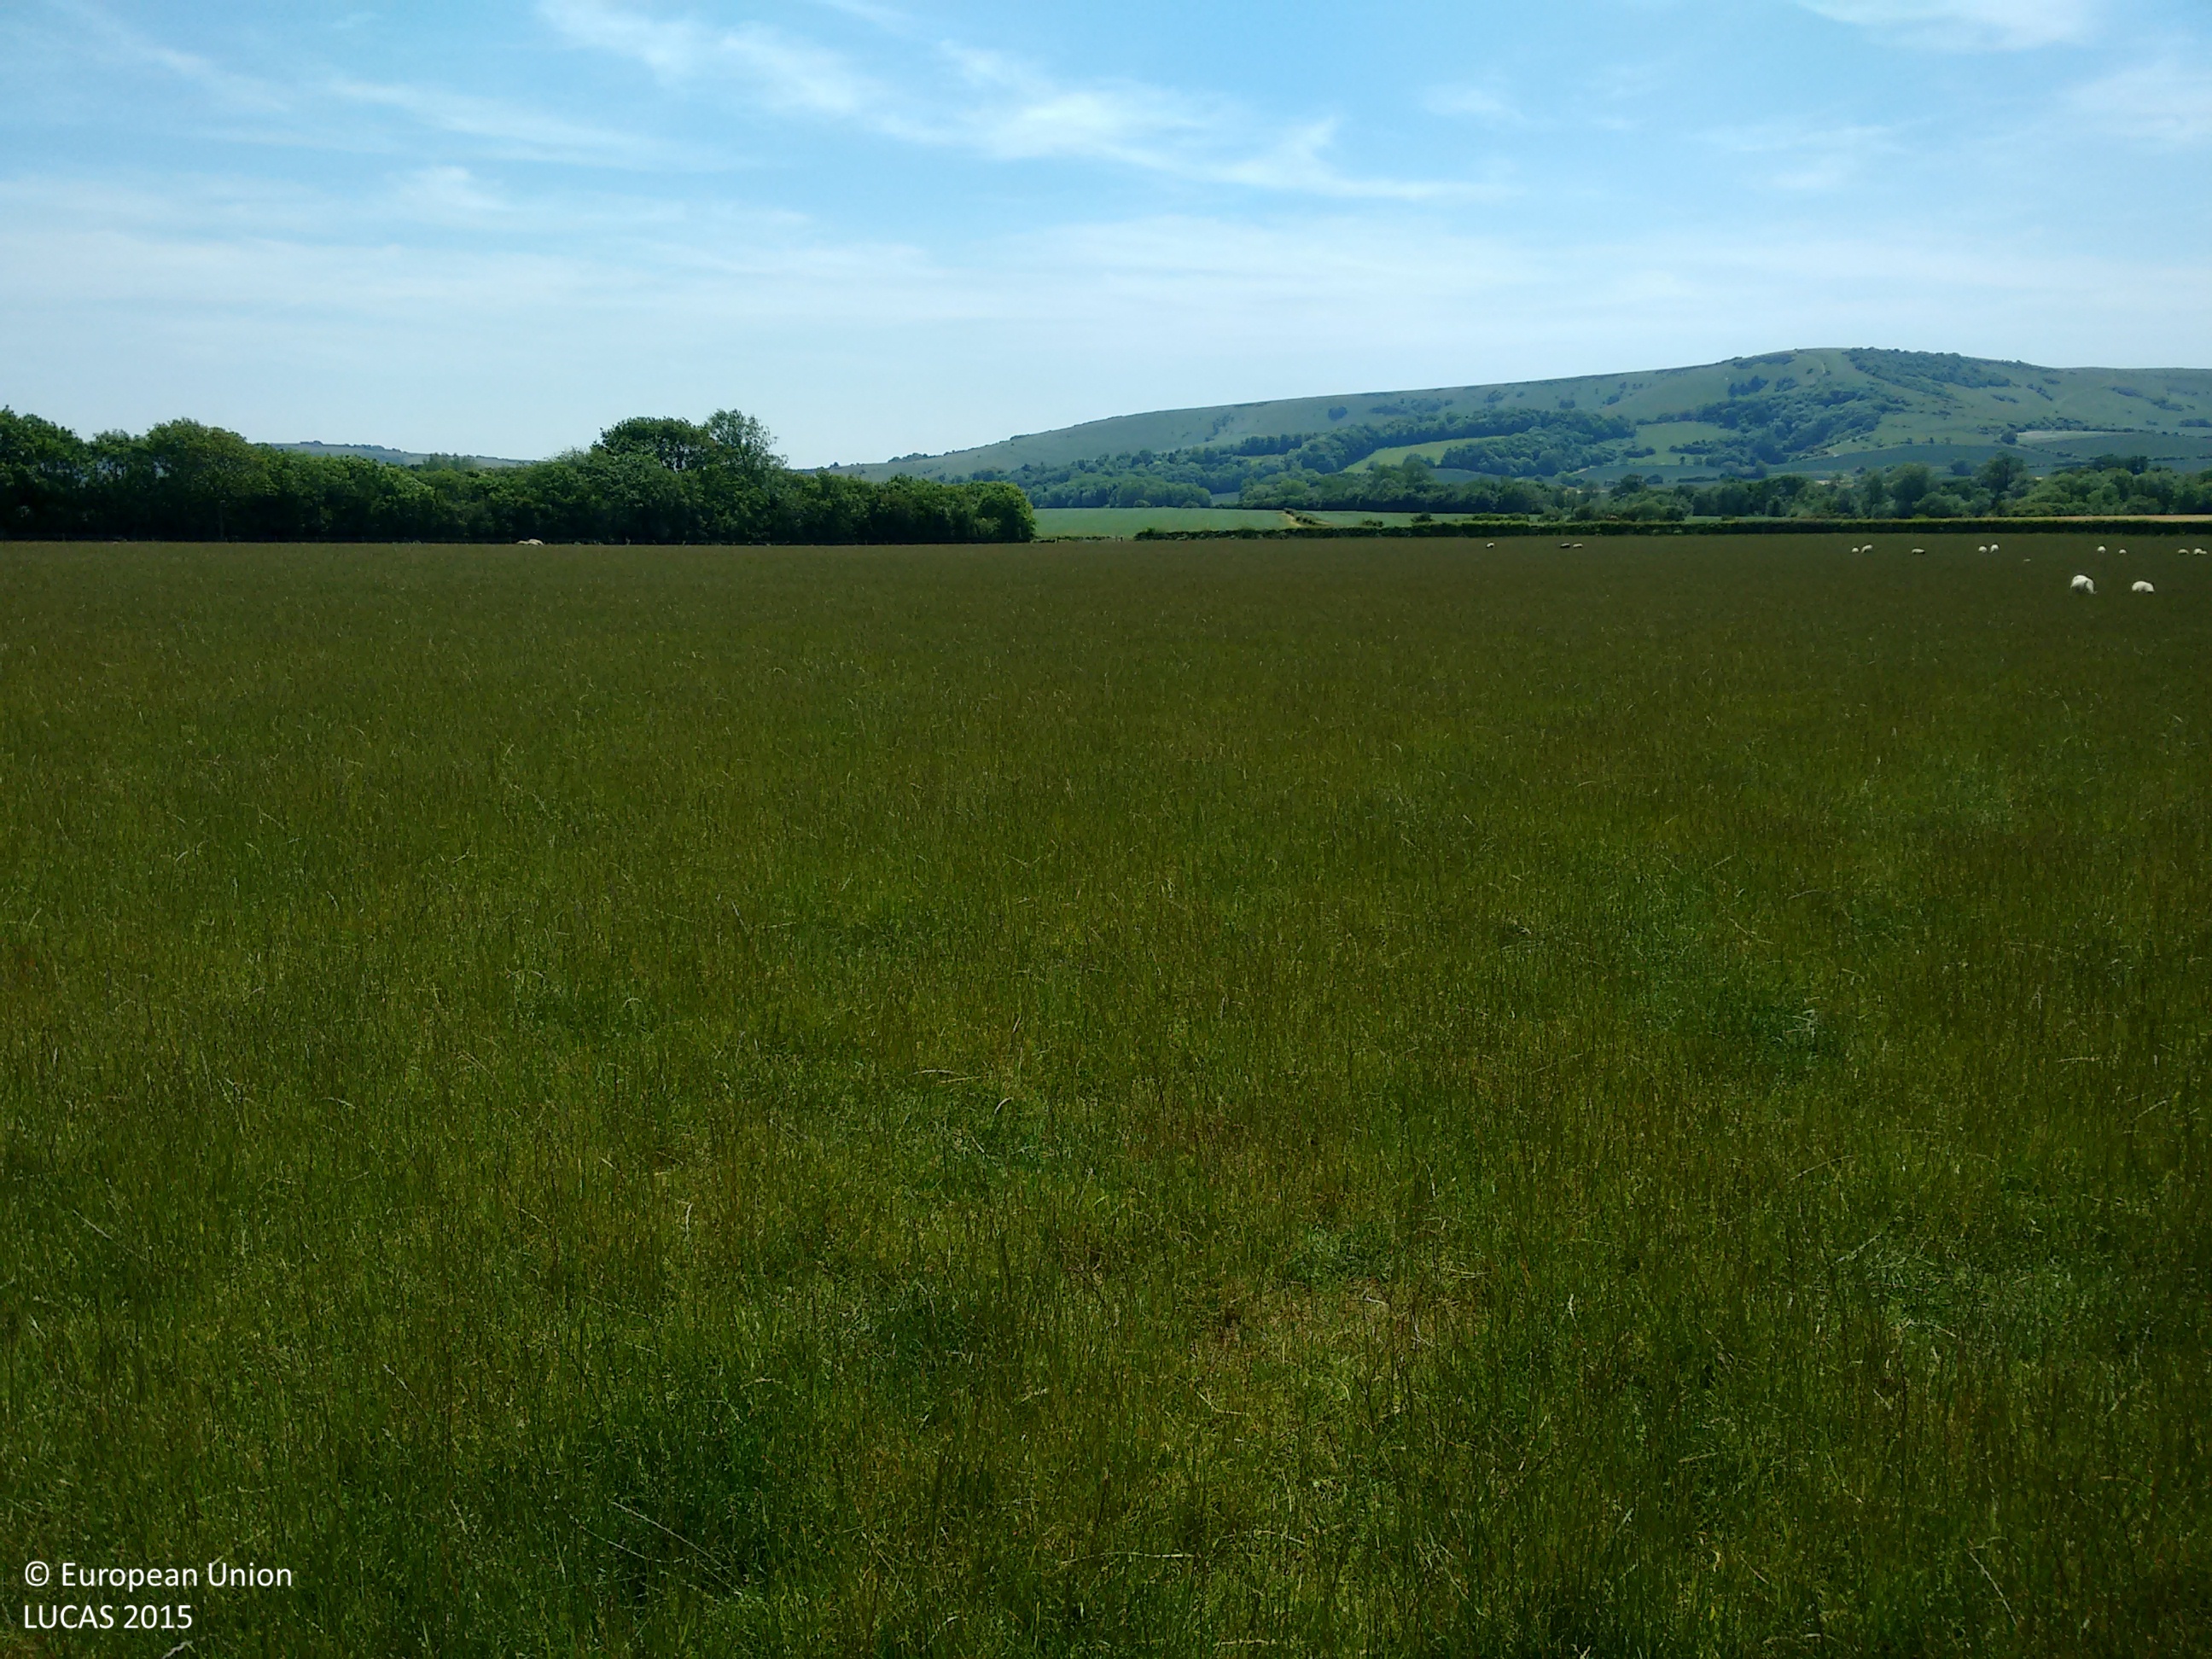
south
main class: Grassland
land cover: Grassland without tree/shrub cover
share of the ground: > 75 %
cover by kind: herbaceous plants 100 %
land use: Agriculture (excluding fallow land and kitchen gardens)
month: June
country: GB
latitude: 50.8312
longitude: 0.2154
